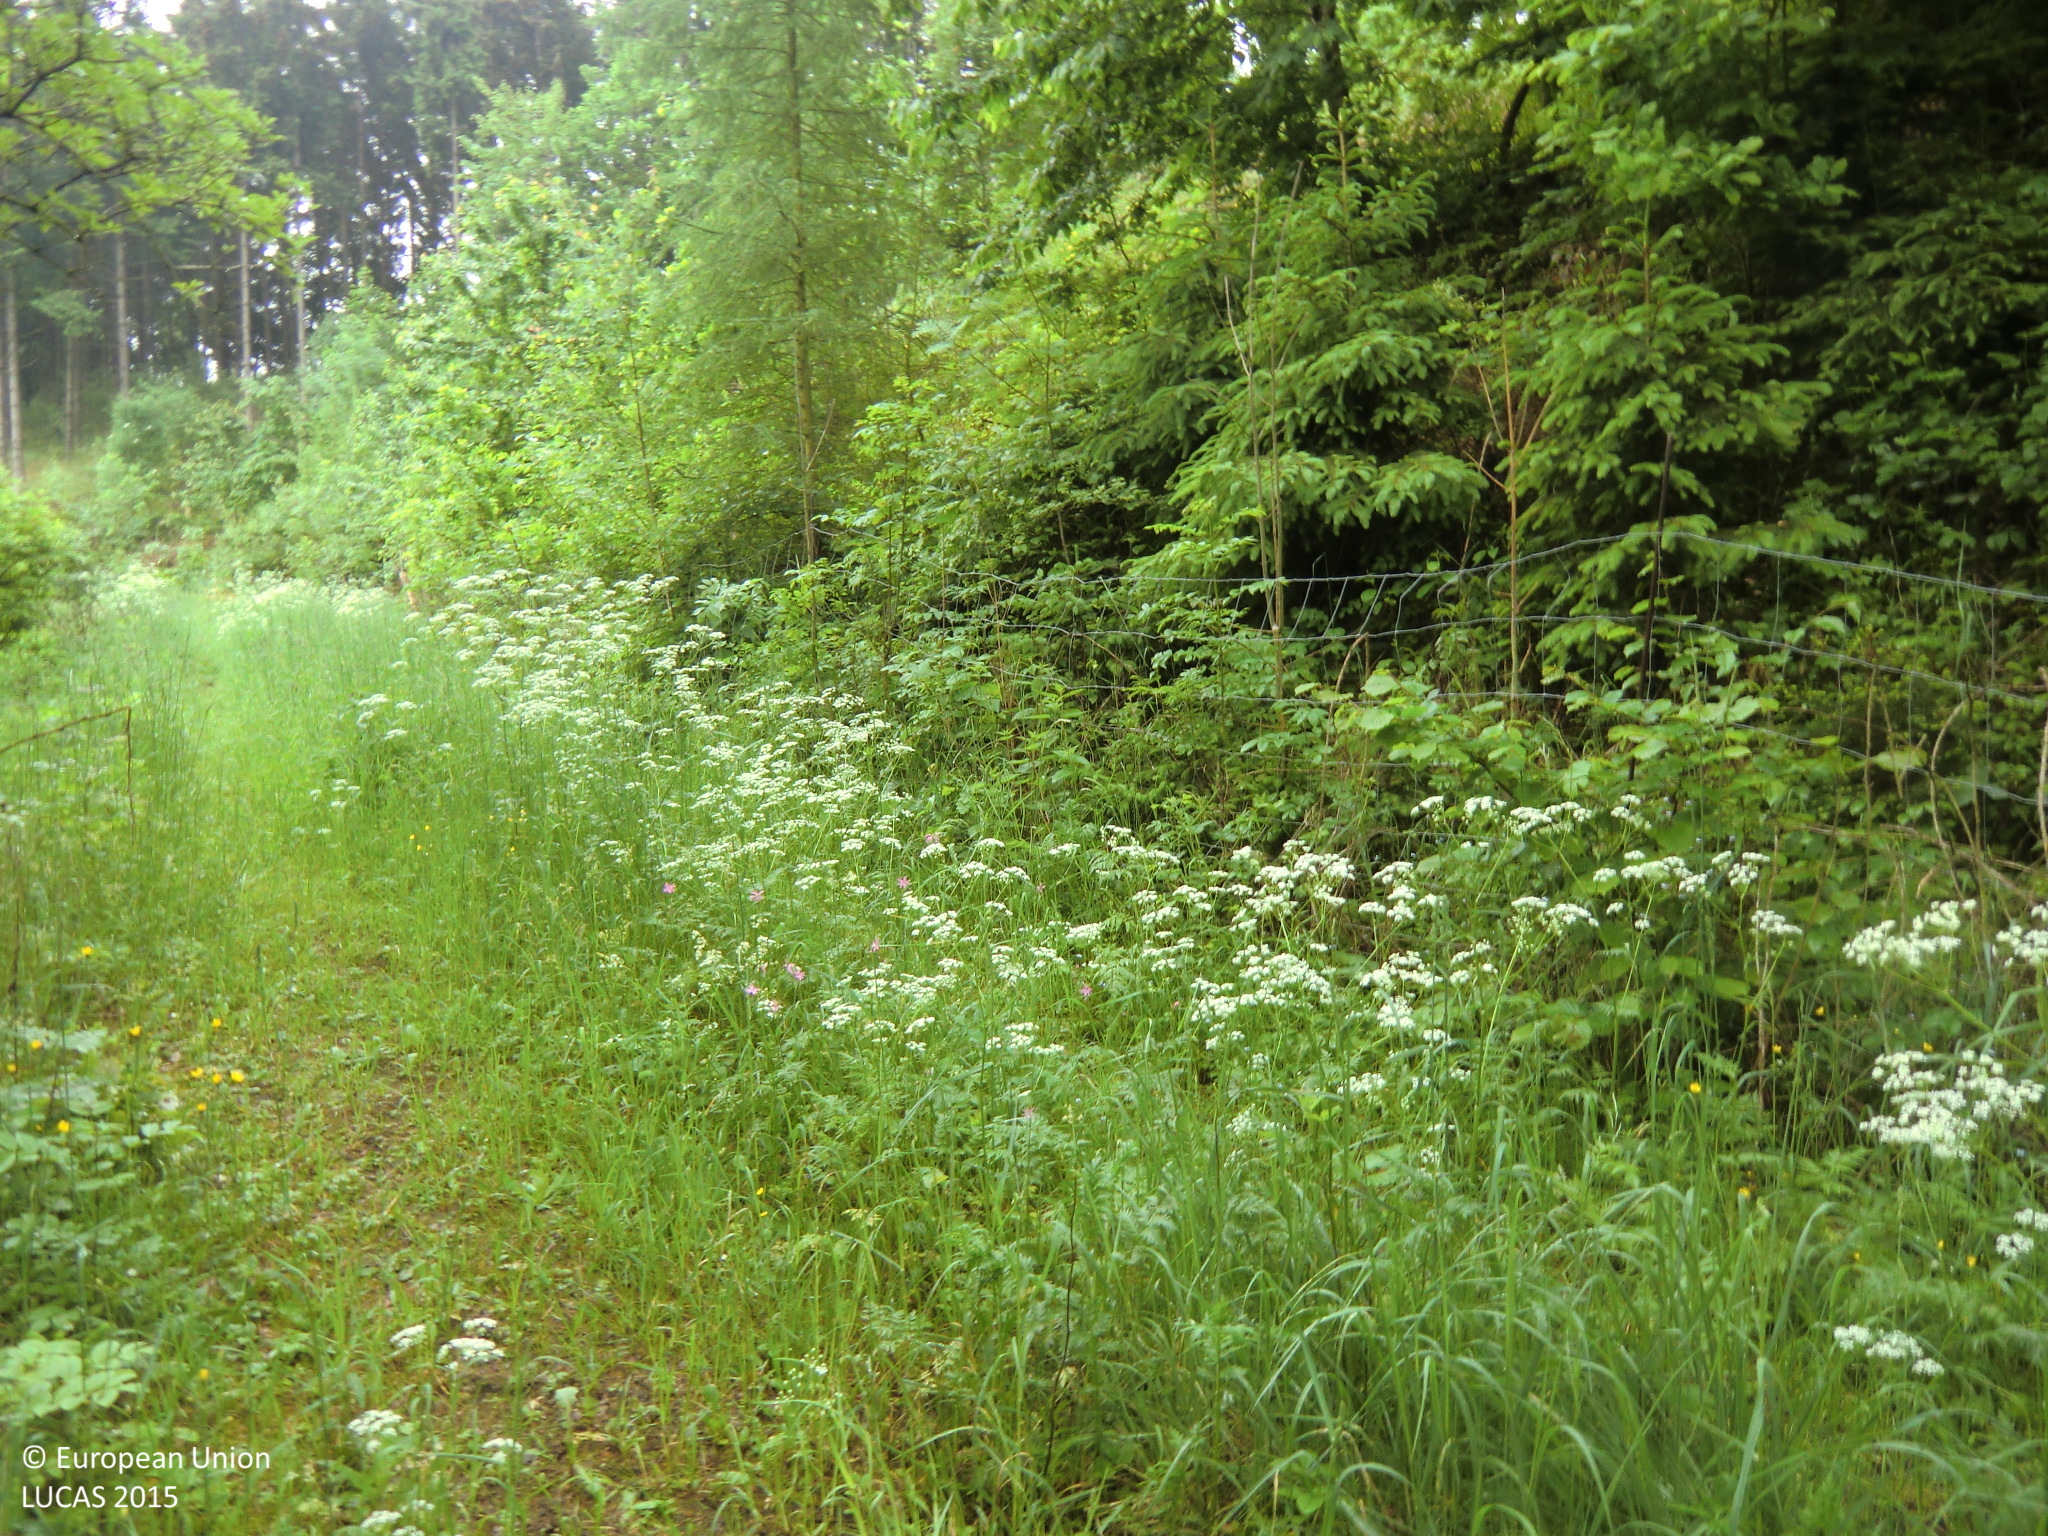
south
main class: Woodland
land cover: Spruce dominated mixed woodland
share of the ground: > 75 %
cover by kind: coniferous forest trees 60 %, broadleaved forest trees 20 %, shrubs 10 %, consolidated bare surface 10 %
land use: Forestry
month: May
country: AT
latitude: 48.3460
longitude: 14.5477
